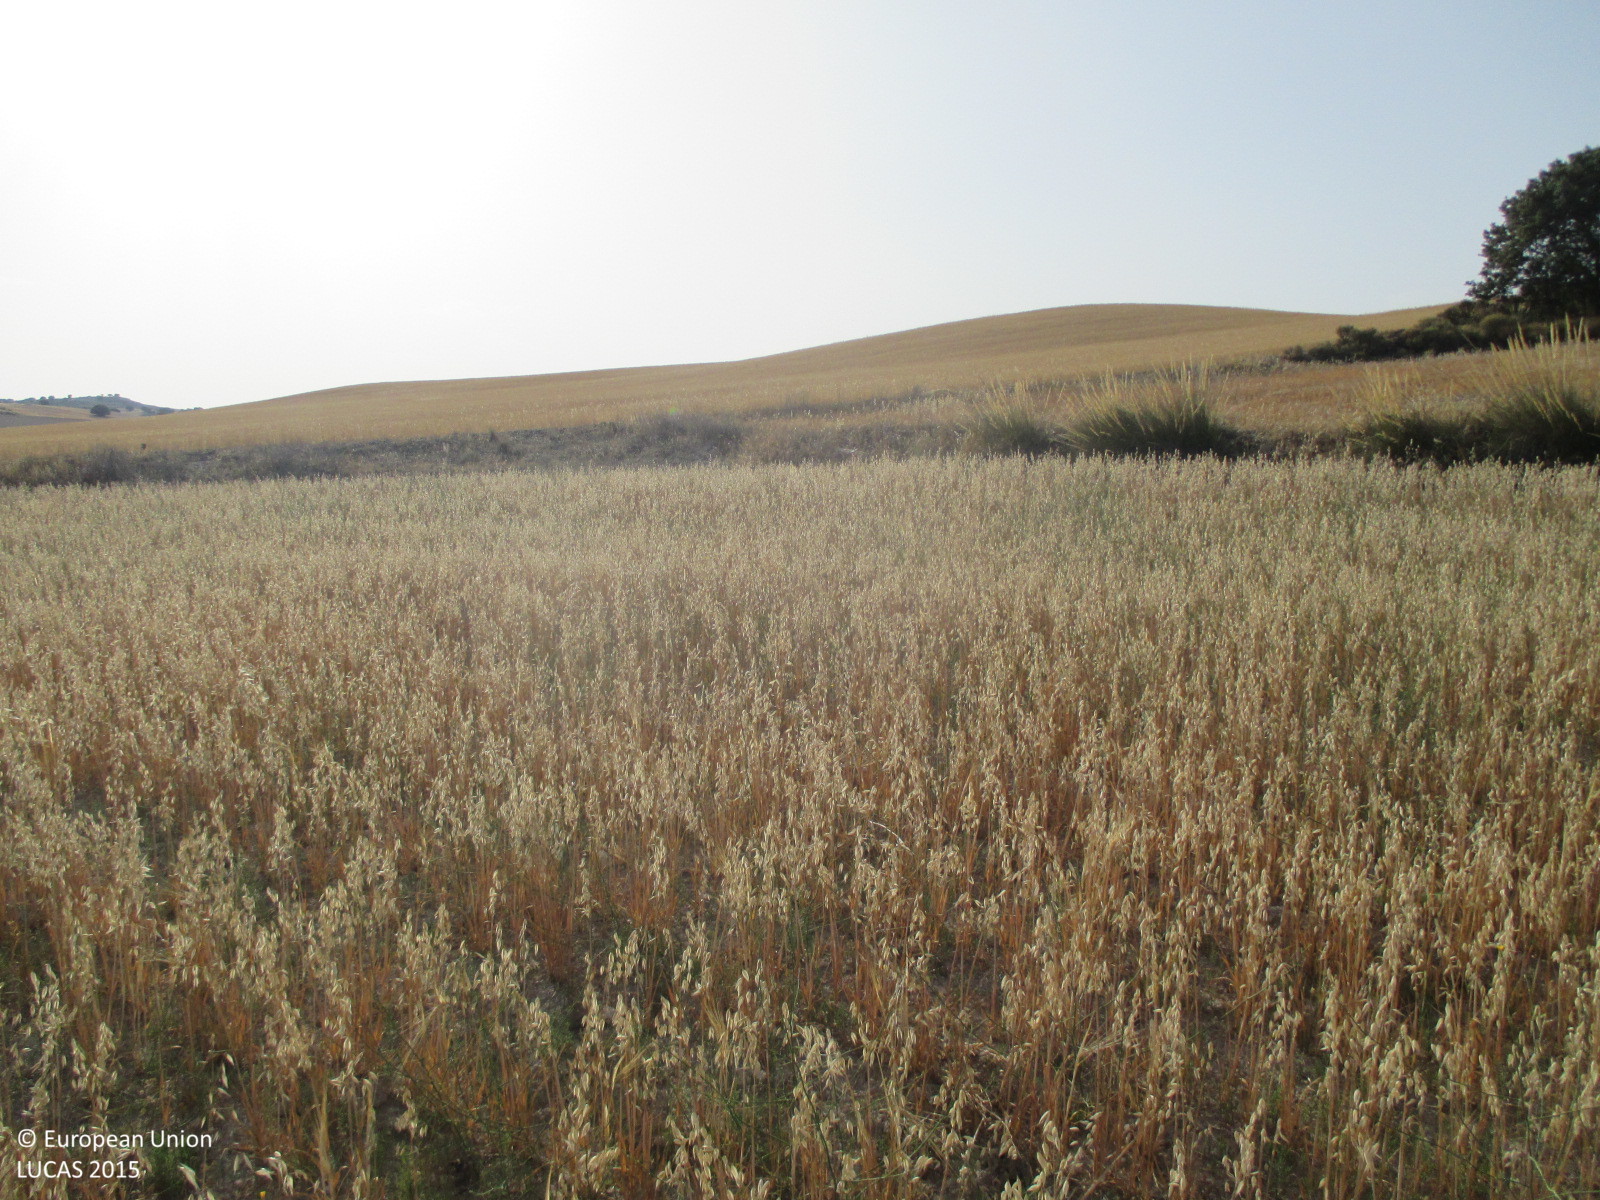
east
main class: Cropland
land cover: Oats
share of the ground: 50 - 75 %
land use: Agriculture (excluding fallow land and kitchen gardens)
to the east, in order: Oats; Grass margins; Barley; Grass margins; Oats; Grass margins; Tracks; Grass margins; Oats
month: July
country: ES
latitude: 37.7578
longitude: -2.3944
